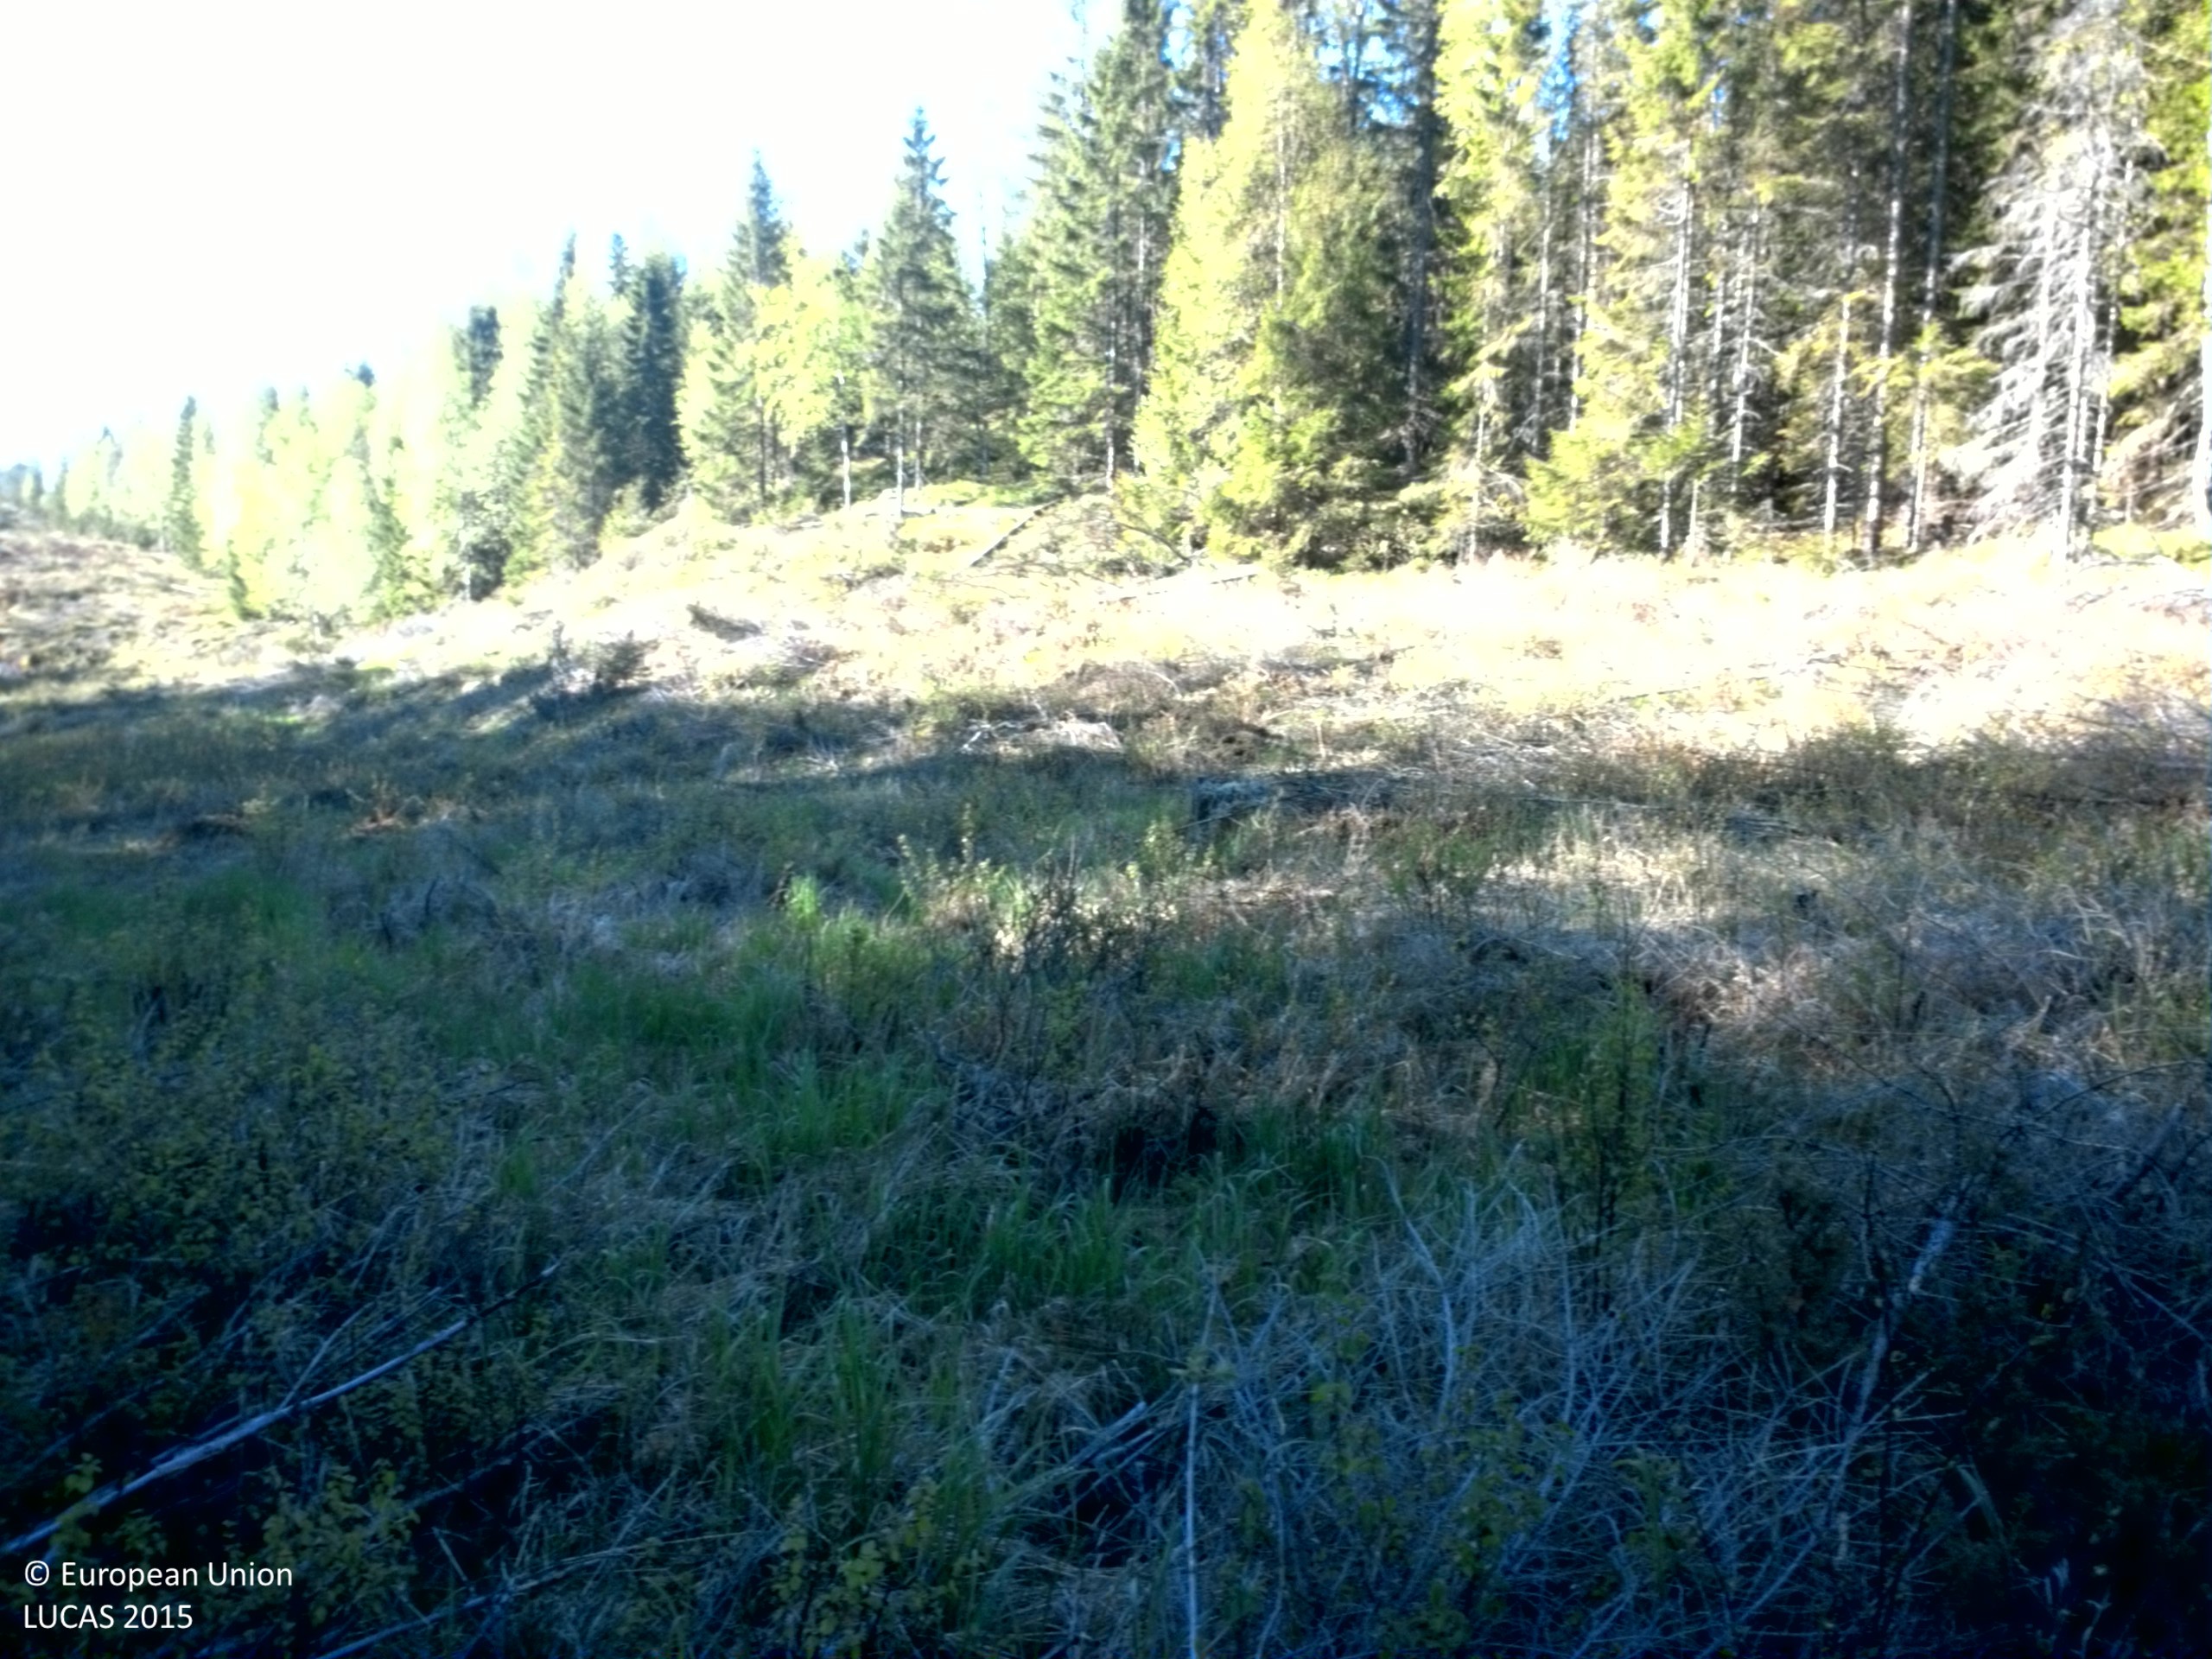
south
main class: Artificial land
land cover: Other artificial areas
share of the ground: > 75 %
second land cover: Broadleaved woodland
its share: 50 - 75 %
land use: Electricity, gas and thermal power distribution
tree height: < 5 m
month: May
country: SE
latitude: 63.0055
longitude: 17.8570
